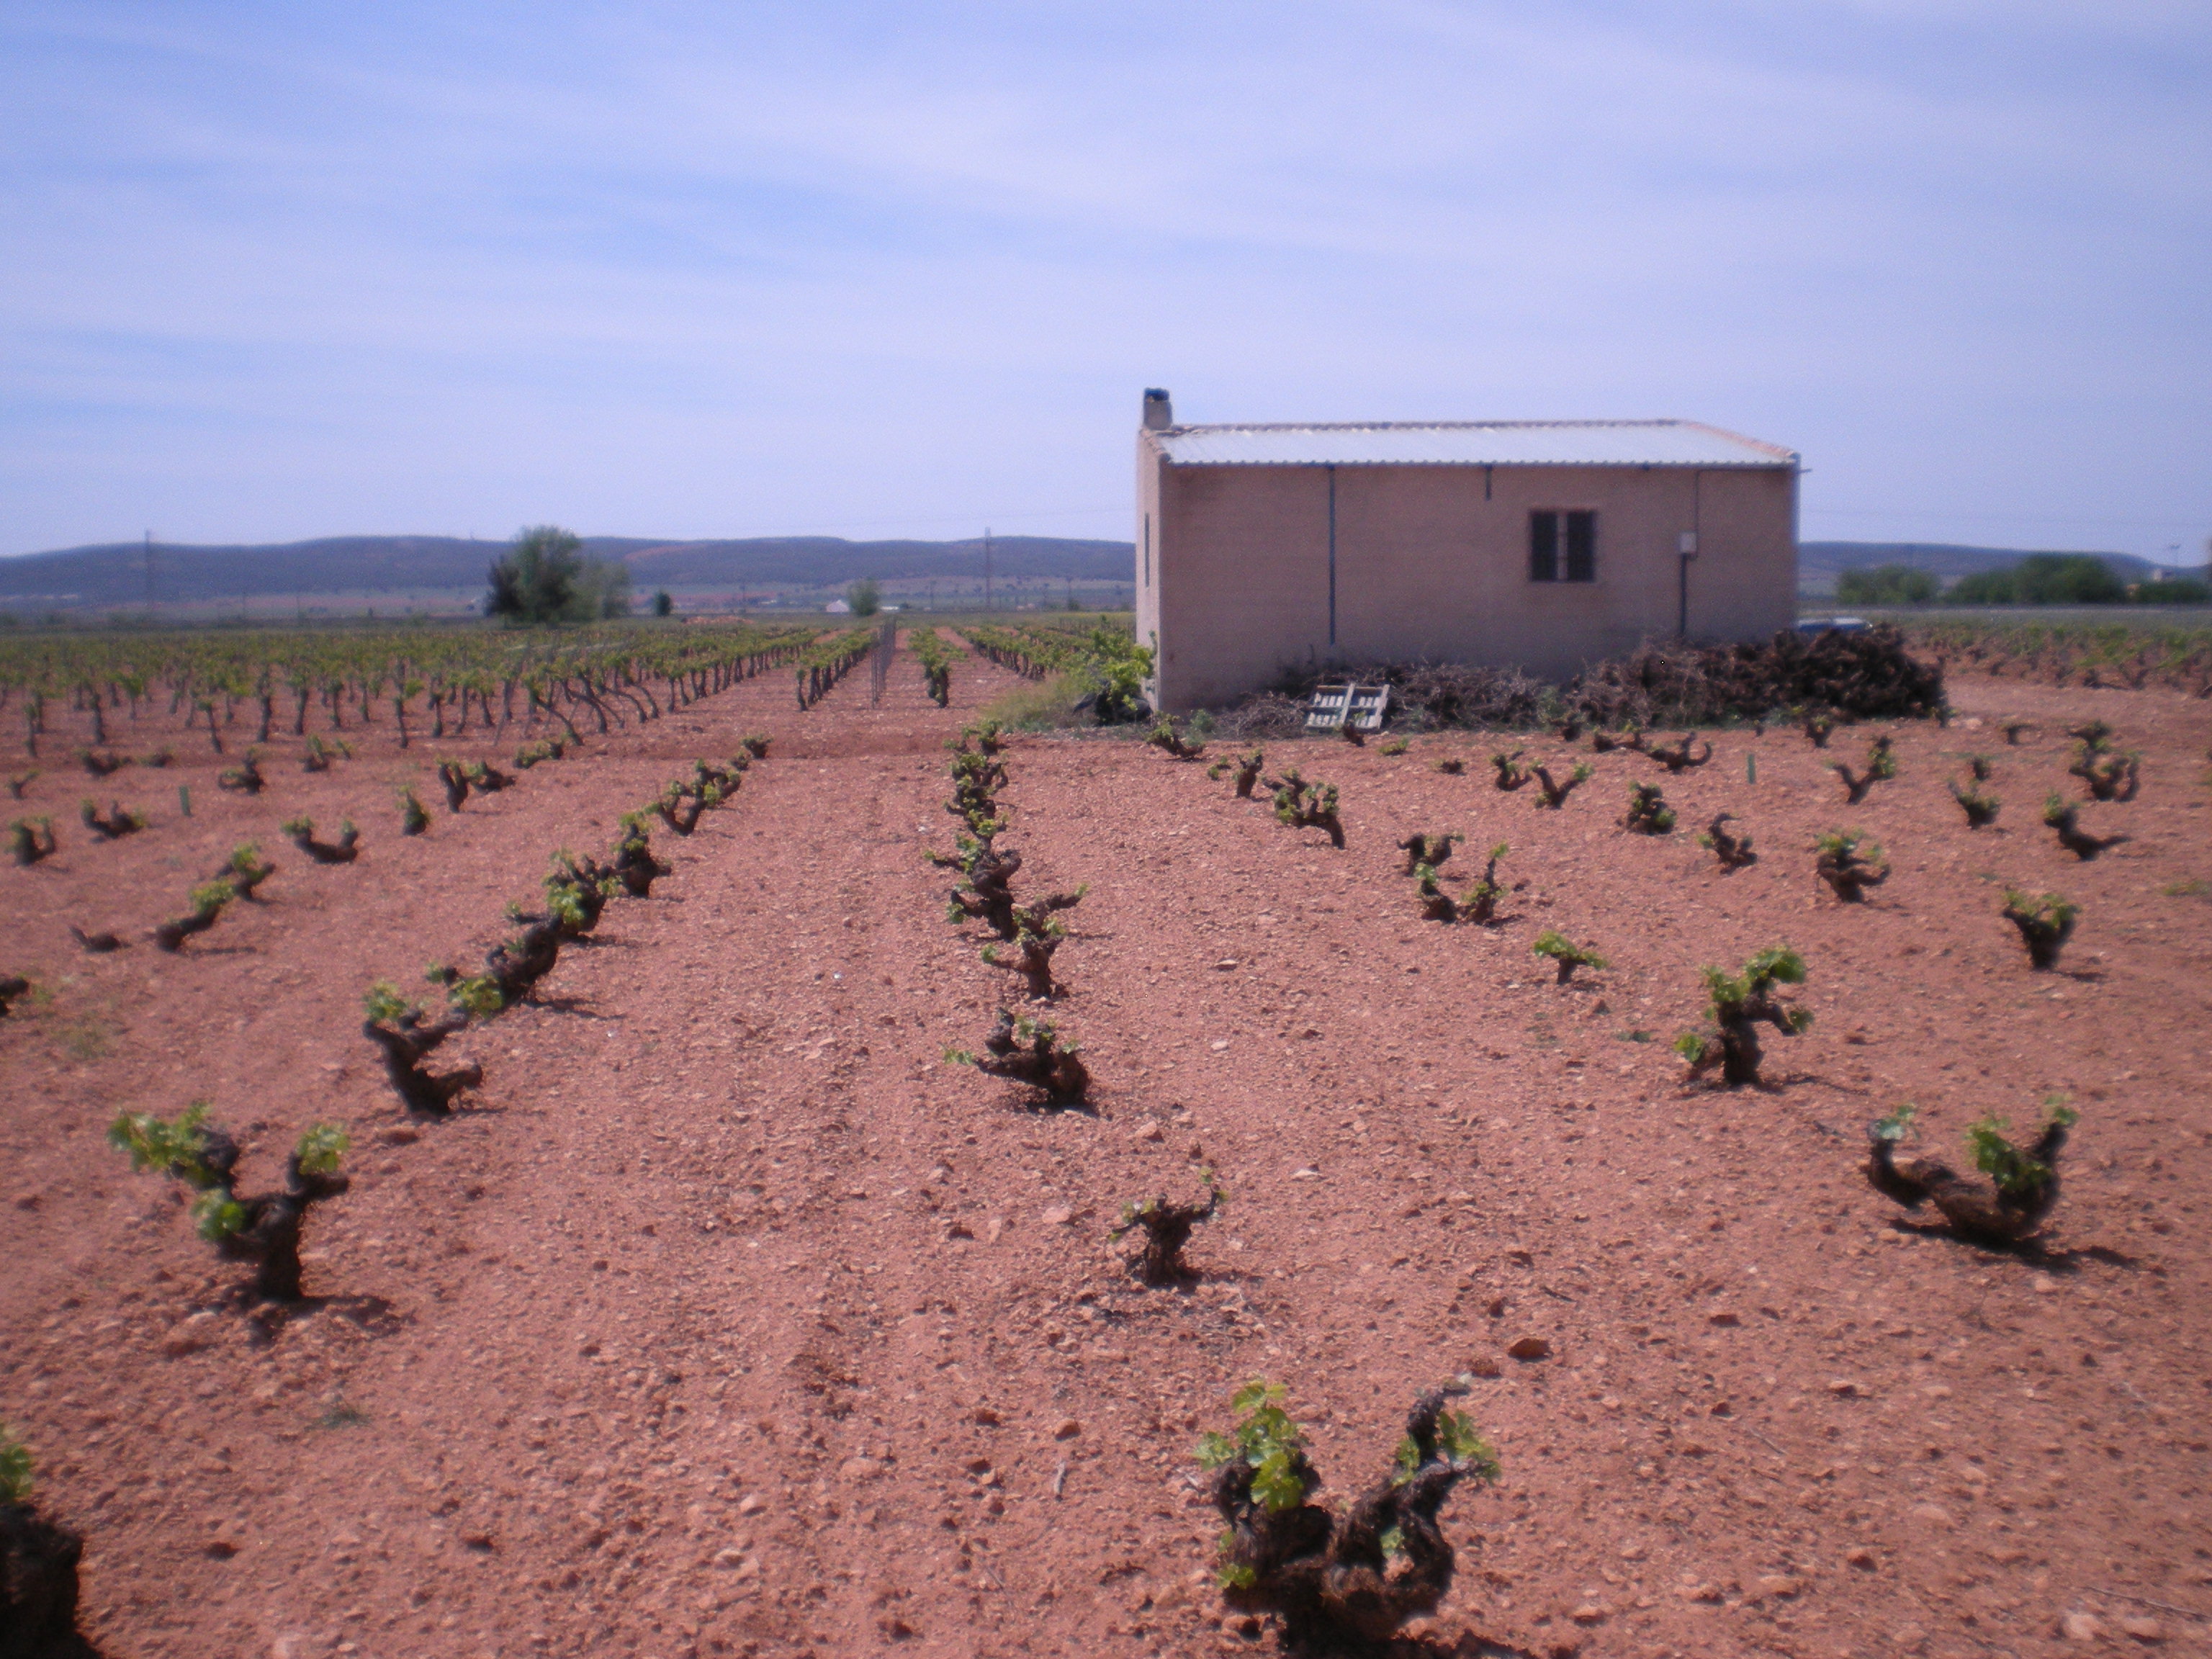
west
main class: Cropland
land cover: Vineyards
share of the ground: < 10 %
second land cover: Other bare soil
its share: > 75 %
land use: Agriculture (excluding fallow land and kitchen gardens)
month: May
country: ES
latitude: 38.8503
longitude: -3.3899
